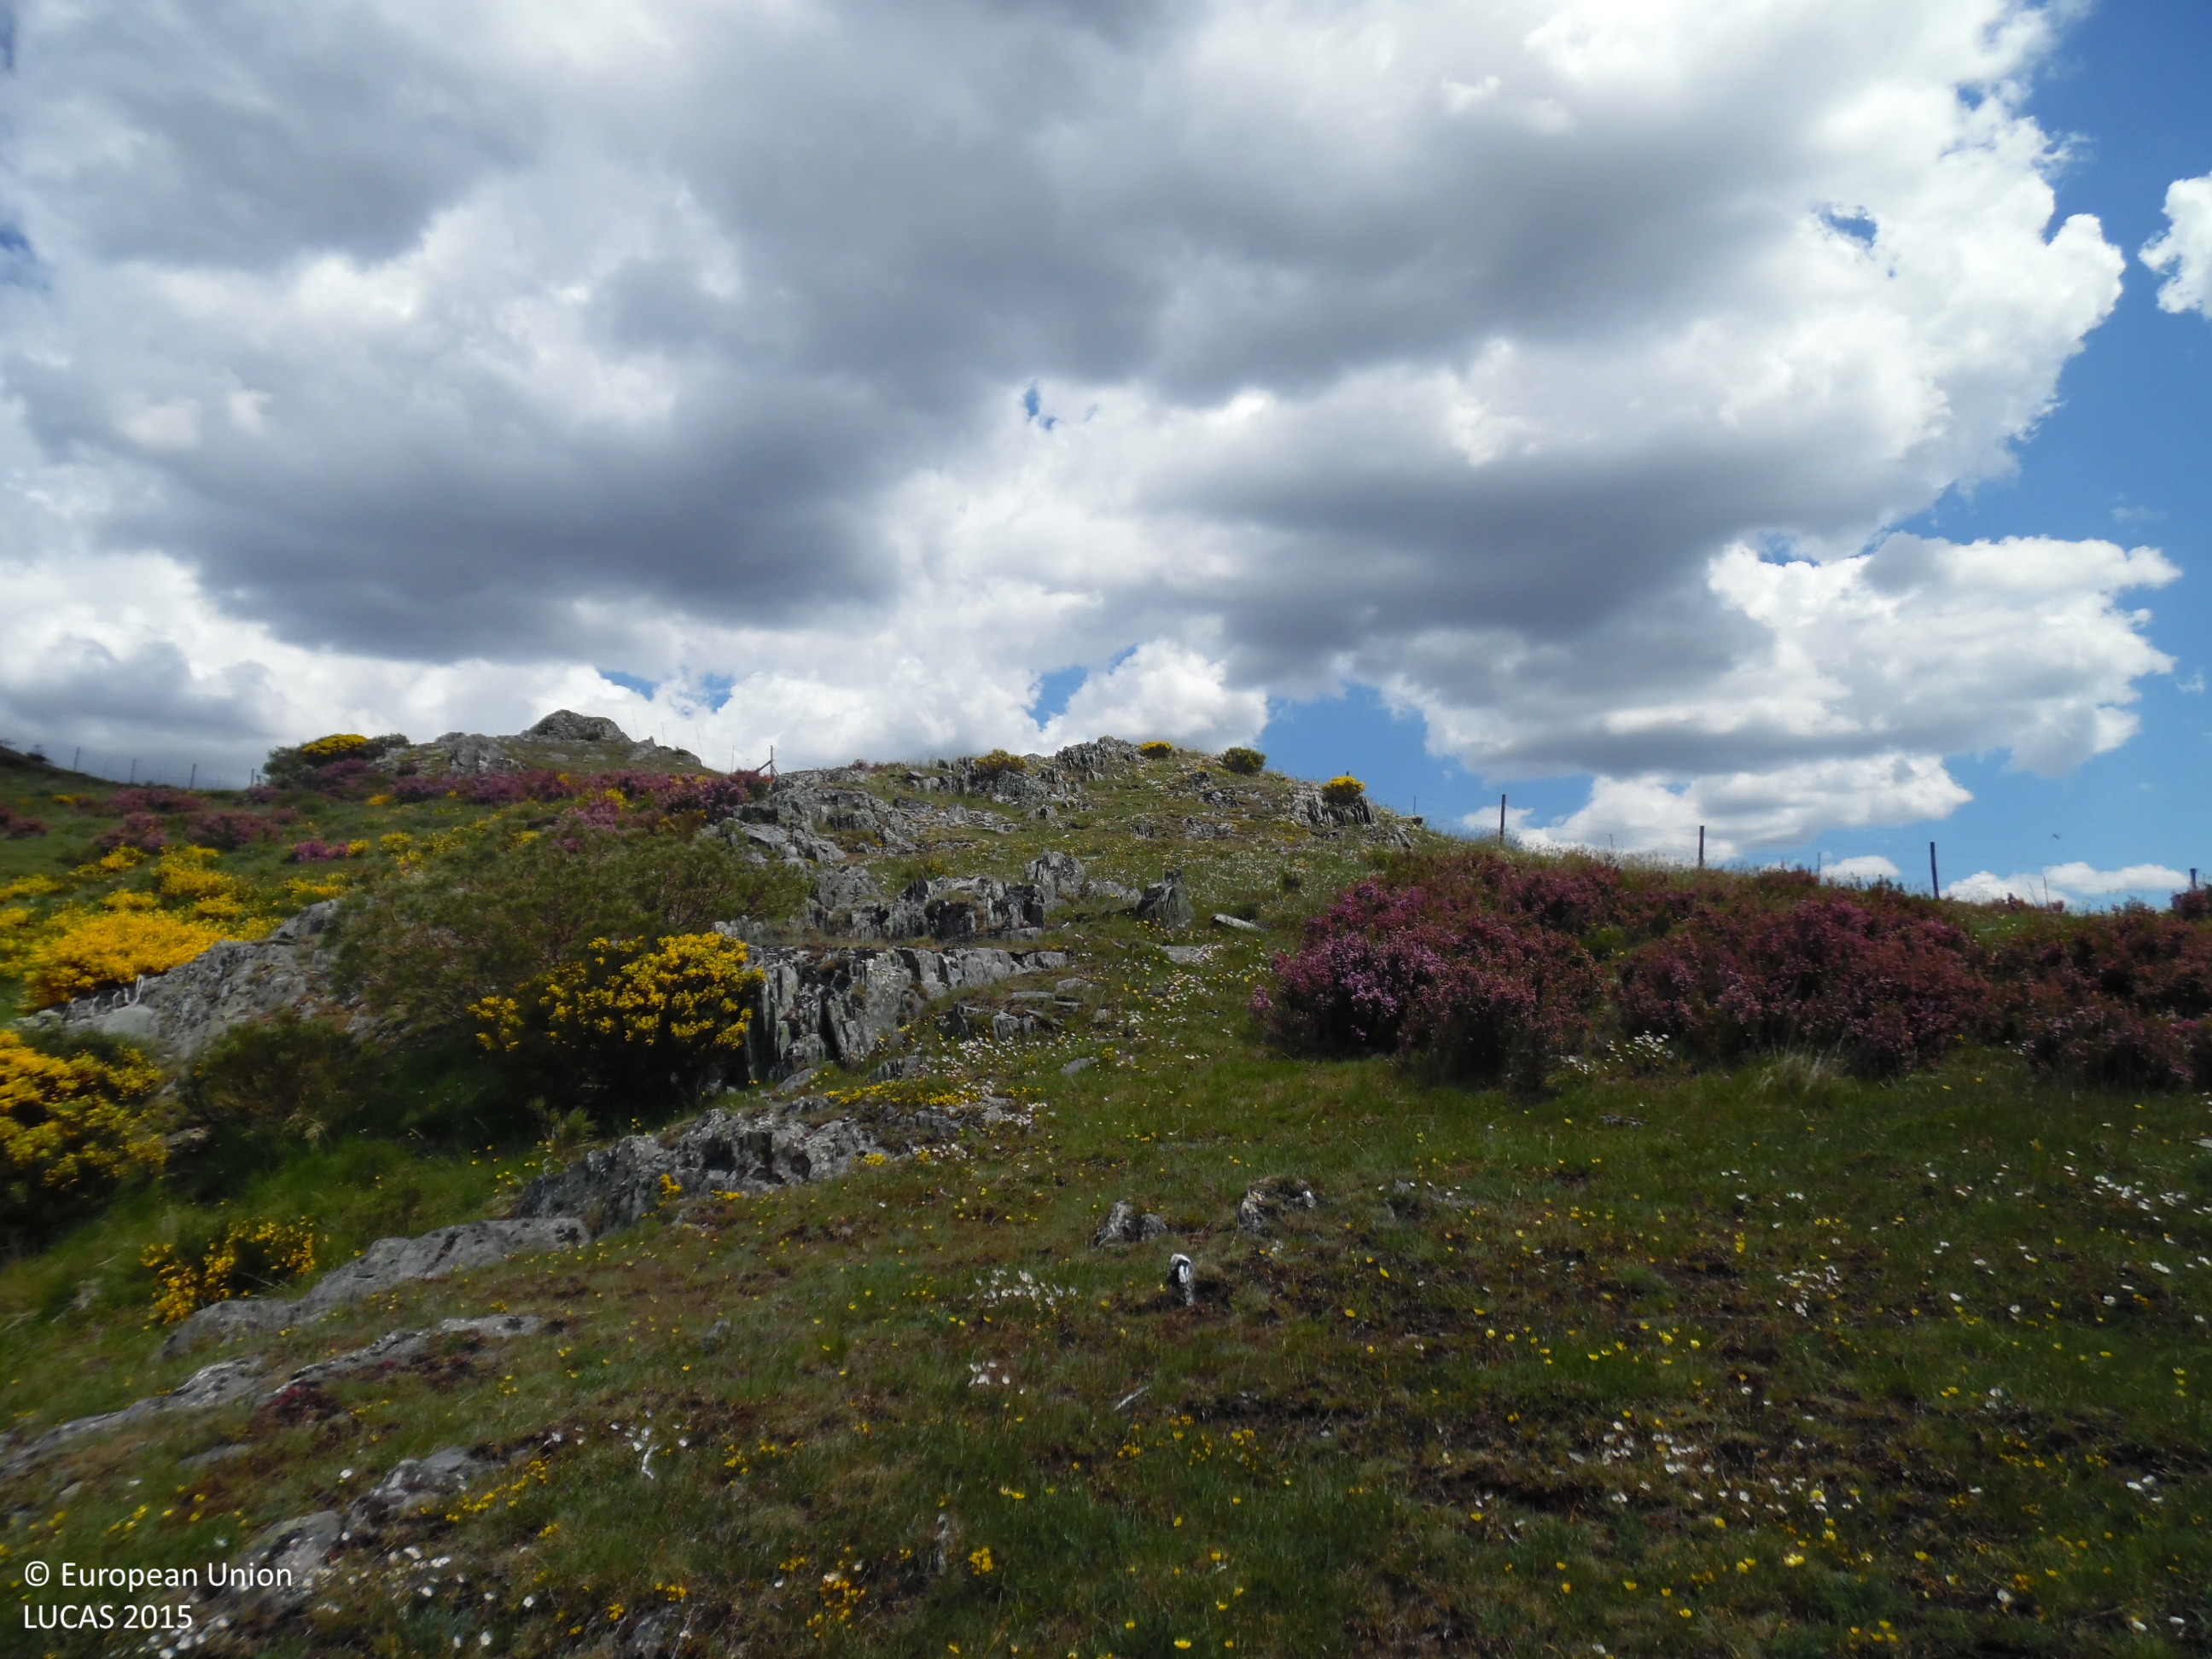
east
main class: Shrubland
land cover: Shrubland without tree cover
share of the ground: 25 - 50 %
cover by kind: herbaceous plants 60 %, shrubs 40 %
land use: Agriculture (excluding fallow land and kitchen gardens)
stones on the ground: 25 - 50 %
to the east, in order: Shrubland without tree cover; Rock outcrops; Grassland without tree/shrub cover; Rock outcrops; Grassland without tree/shrub cover; Fences; Shrubland without tree cover; Tracks; Grassland without tree/shrub cover; Shrubland without tree cover; Grassland without tree/shrub cover
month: May
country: ES
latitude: 42.8813
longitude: -6.2147
